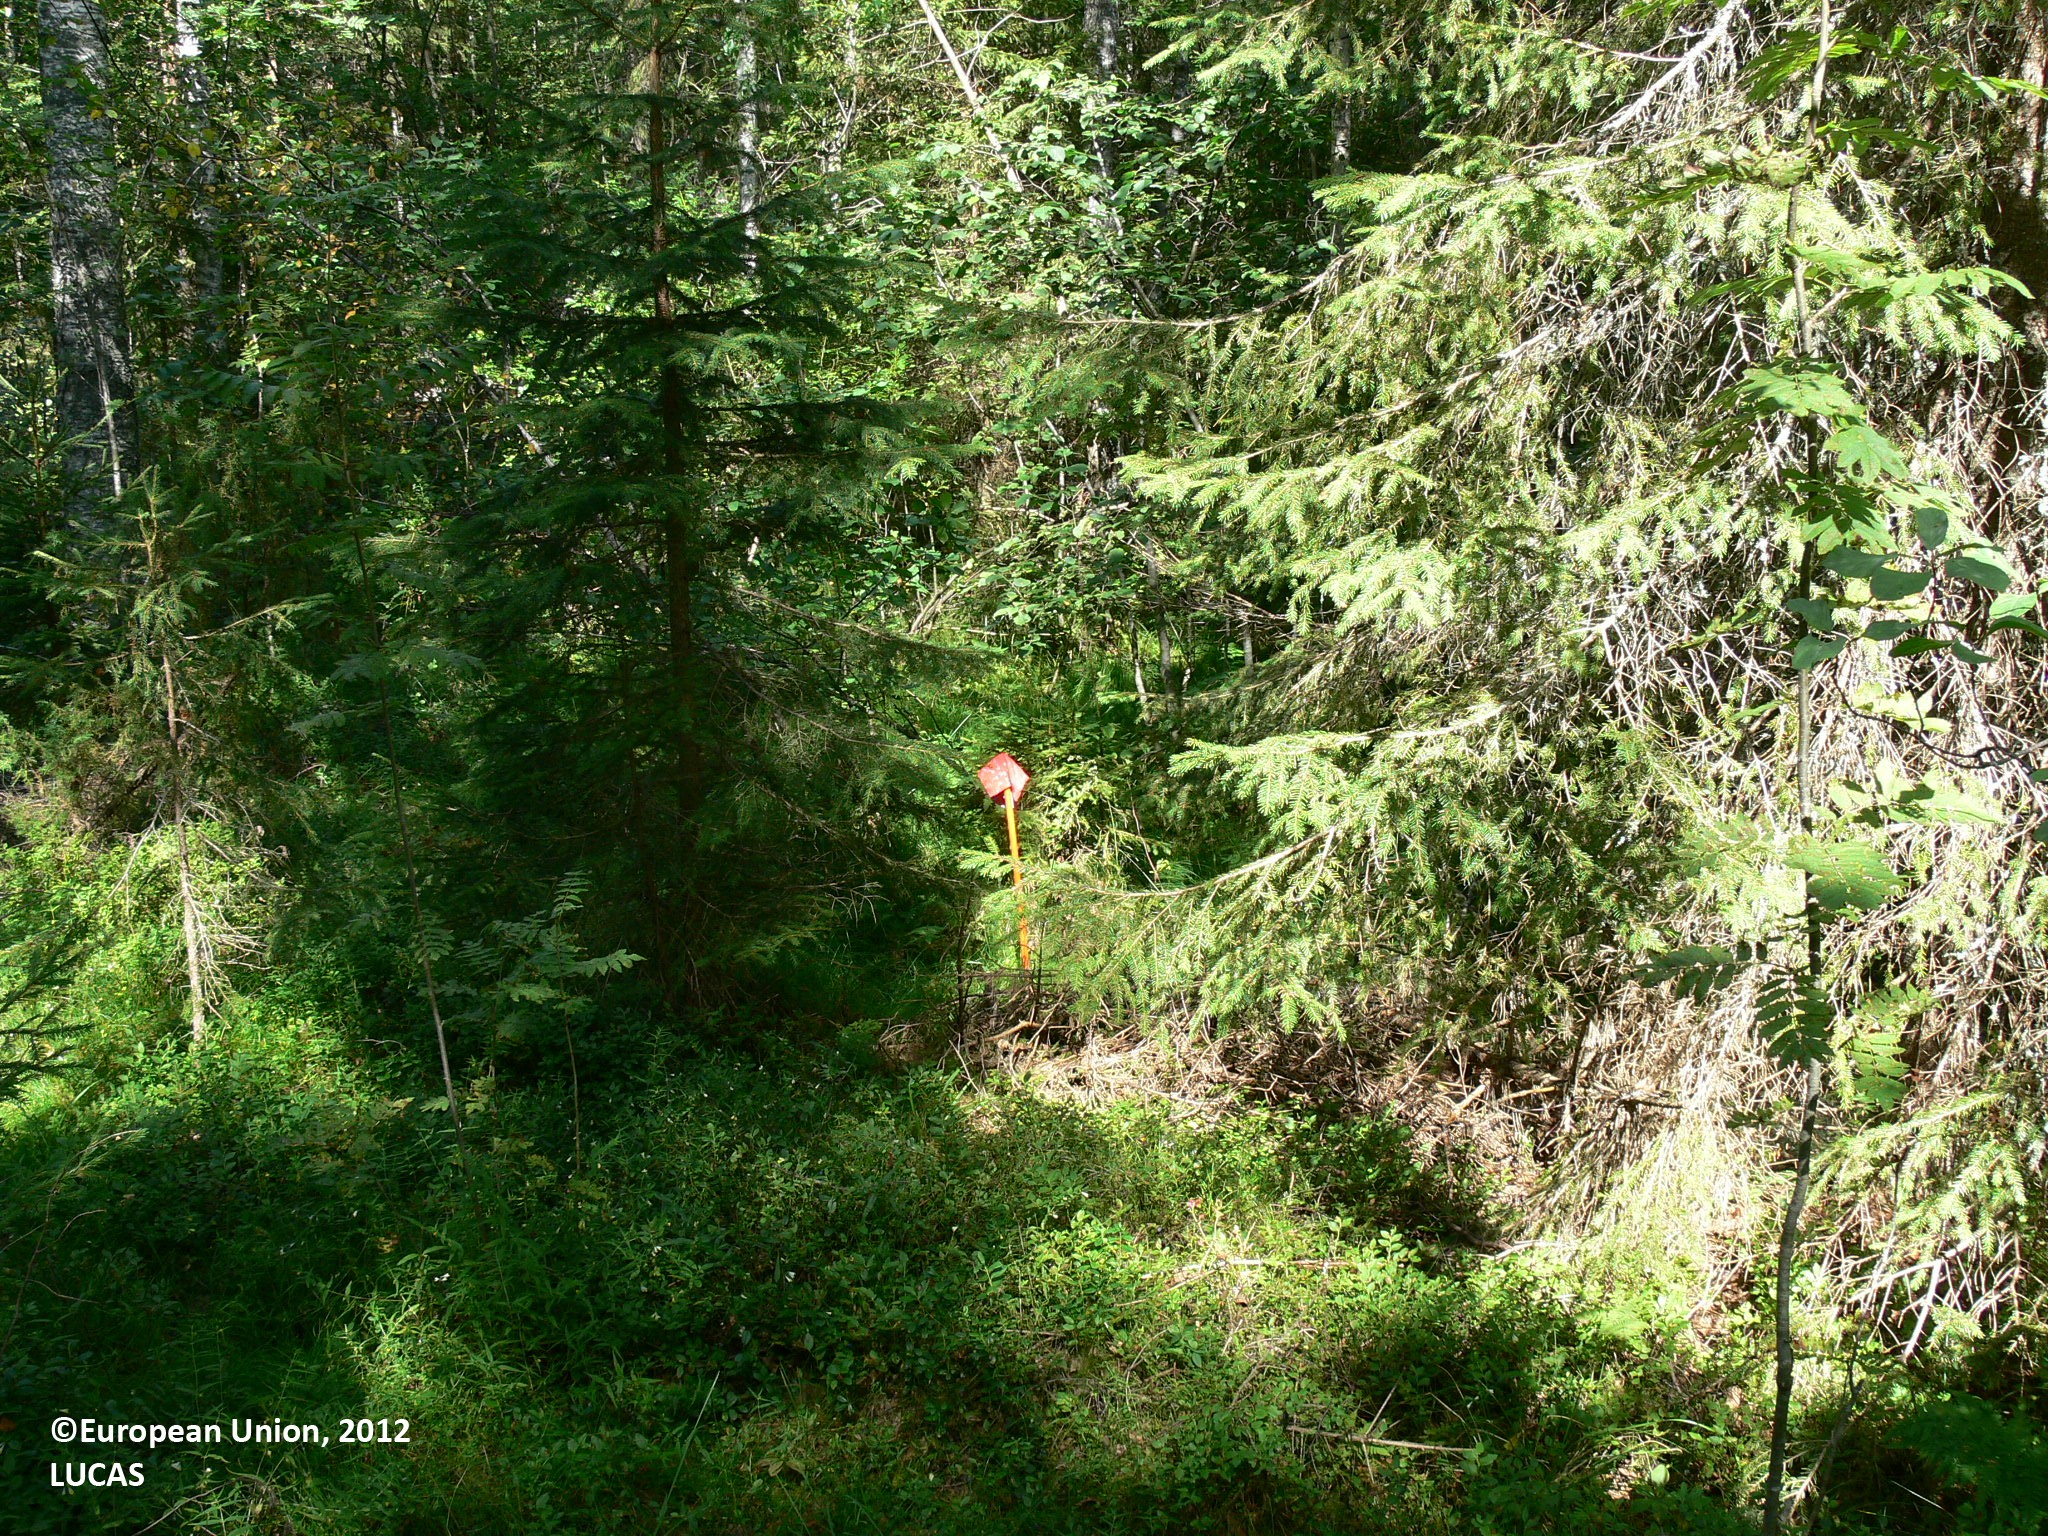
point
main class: Woodland
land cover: Other mixed woodland
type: boreal forest
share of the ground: > 75 %
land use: Forestry
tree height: > 5 m
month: August
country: FI
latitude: 62.1325
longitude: 30.3590
